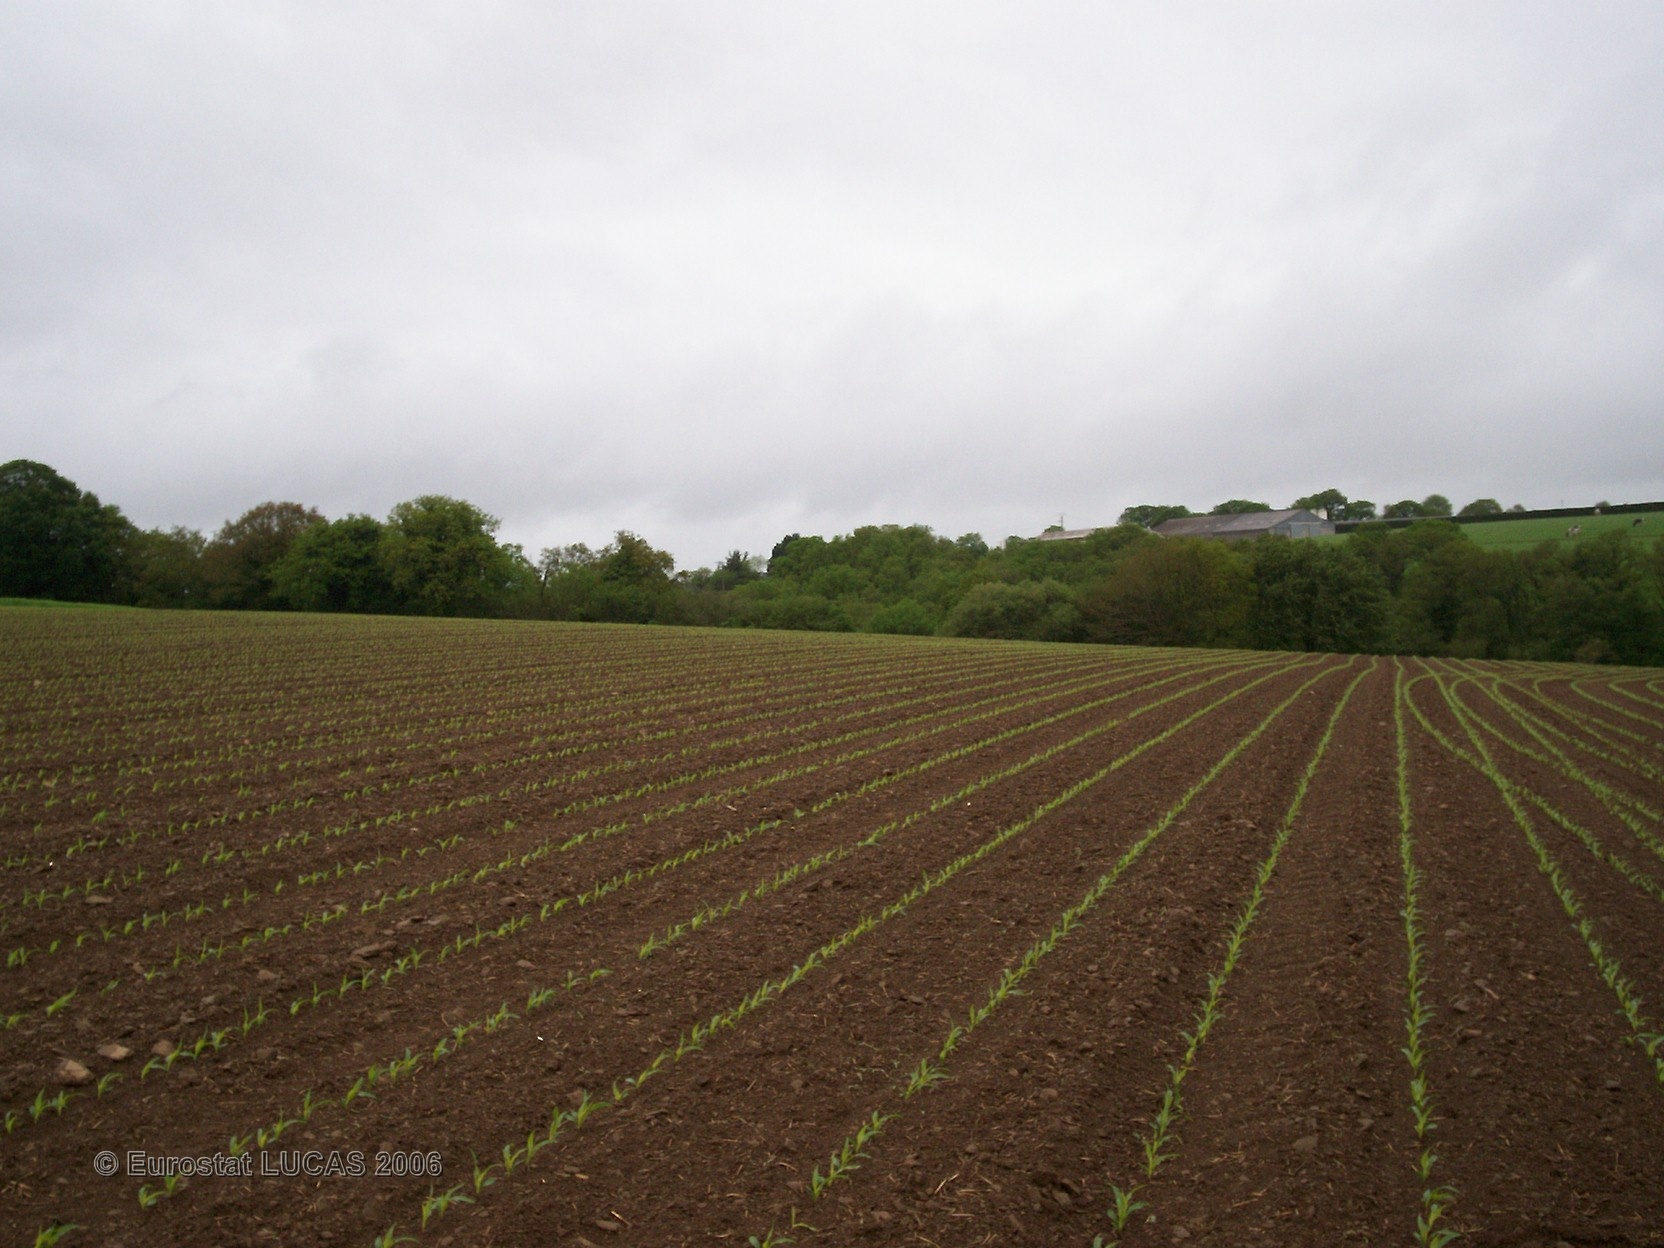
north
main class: Cropland
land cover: Maize
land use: Agriculture (excluding fallow land and kitchen gardens)
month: May
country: FR
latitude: 48.2994
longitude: -3.6560
